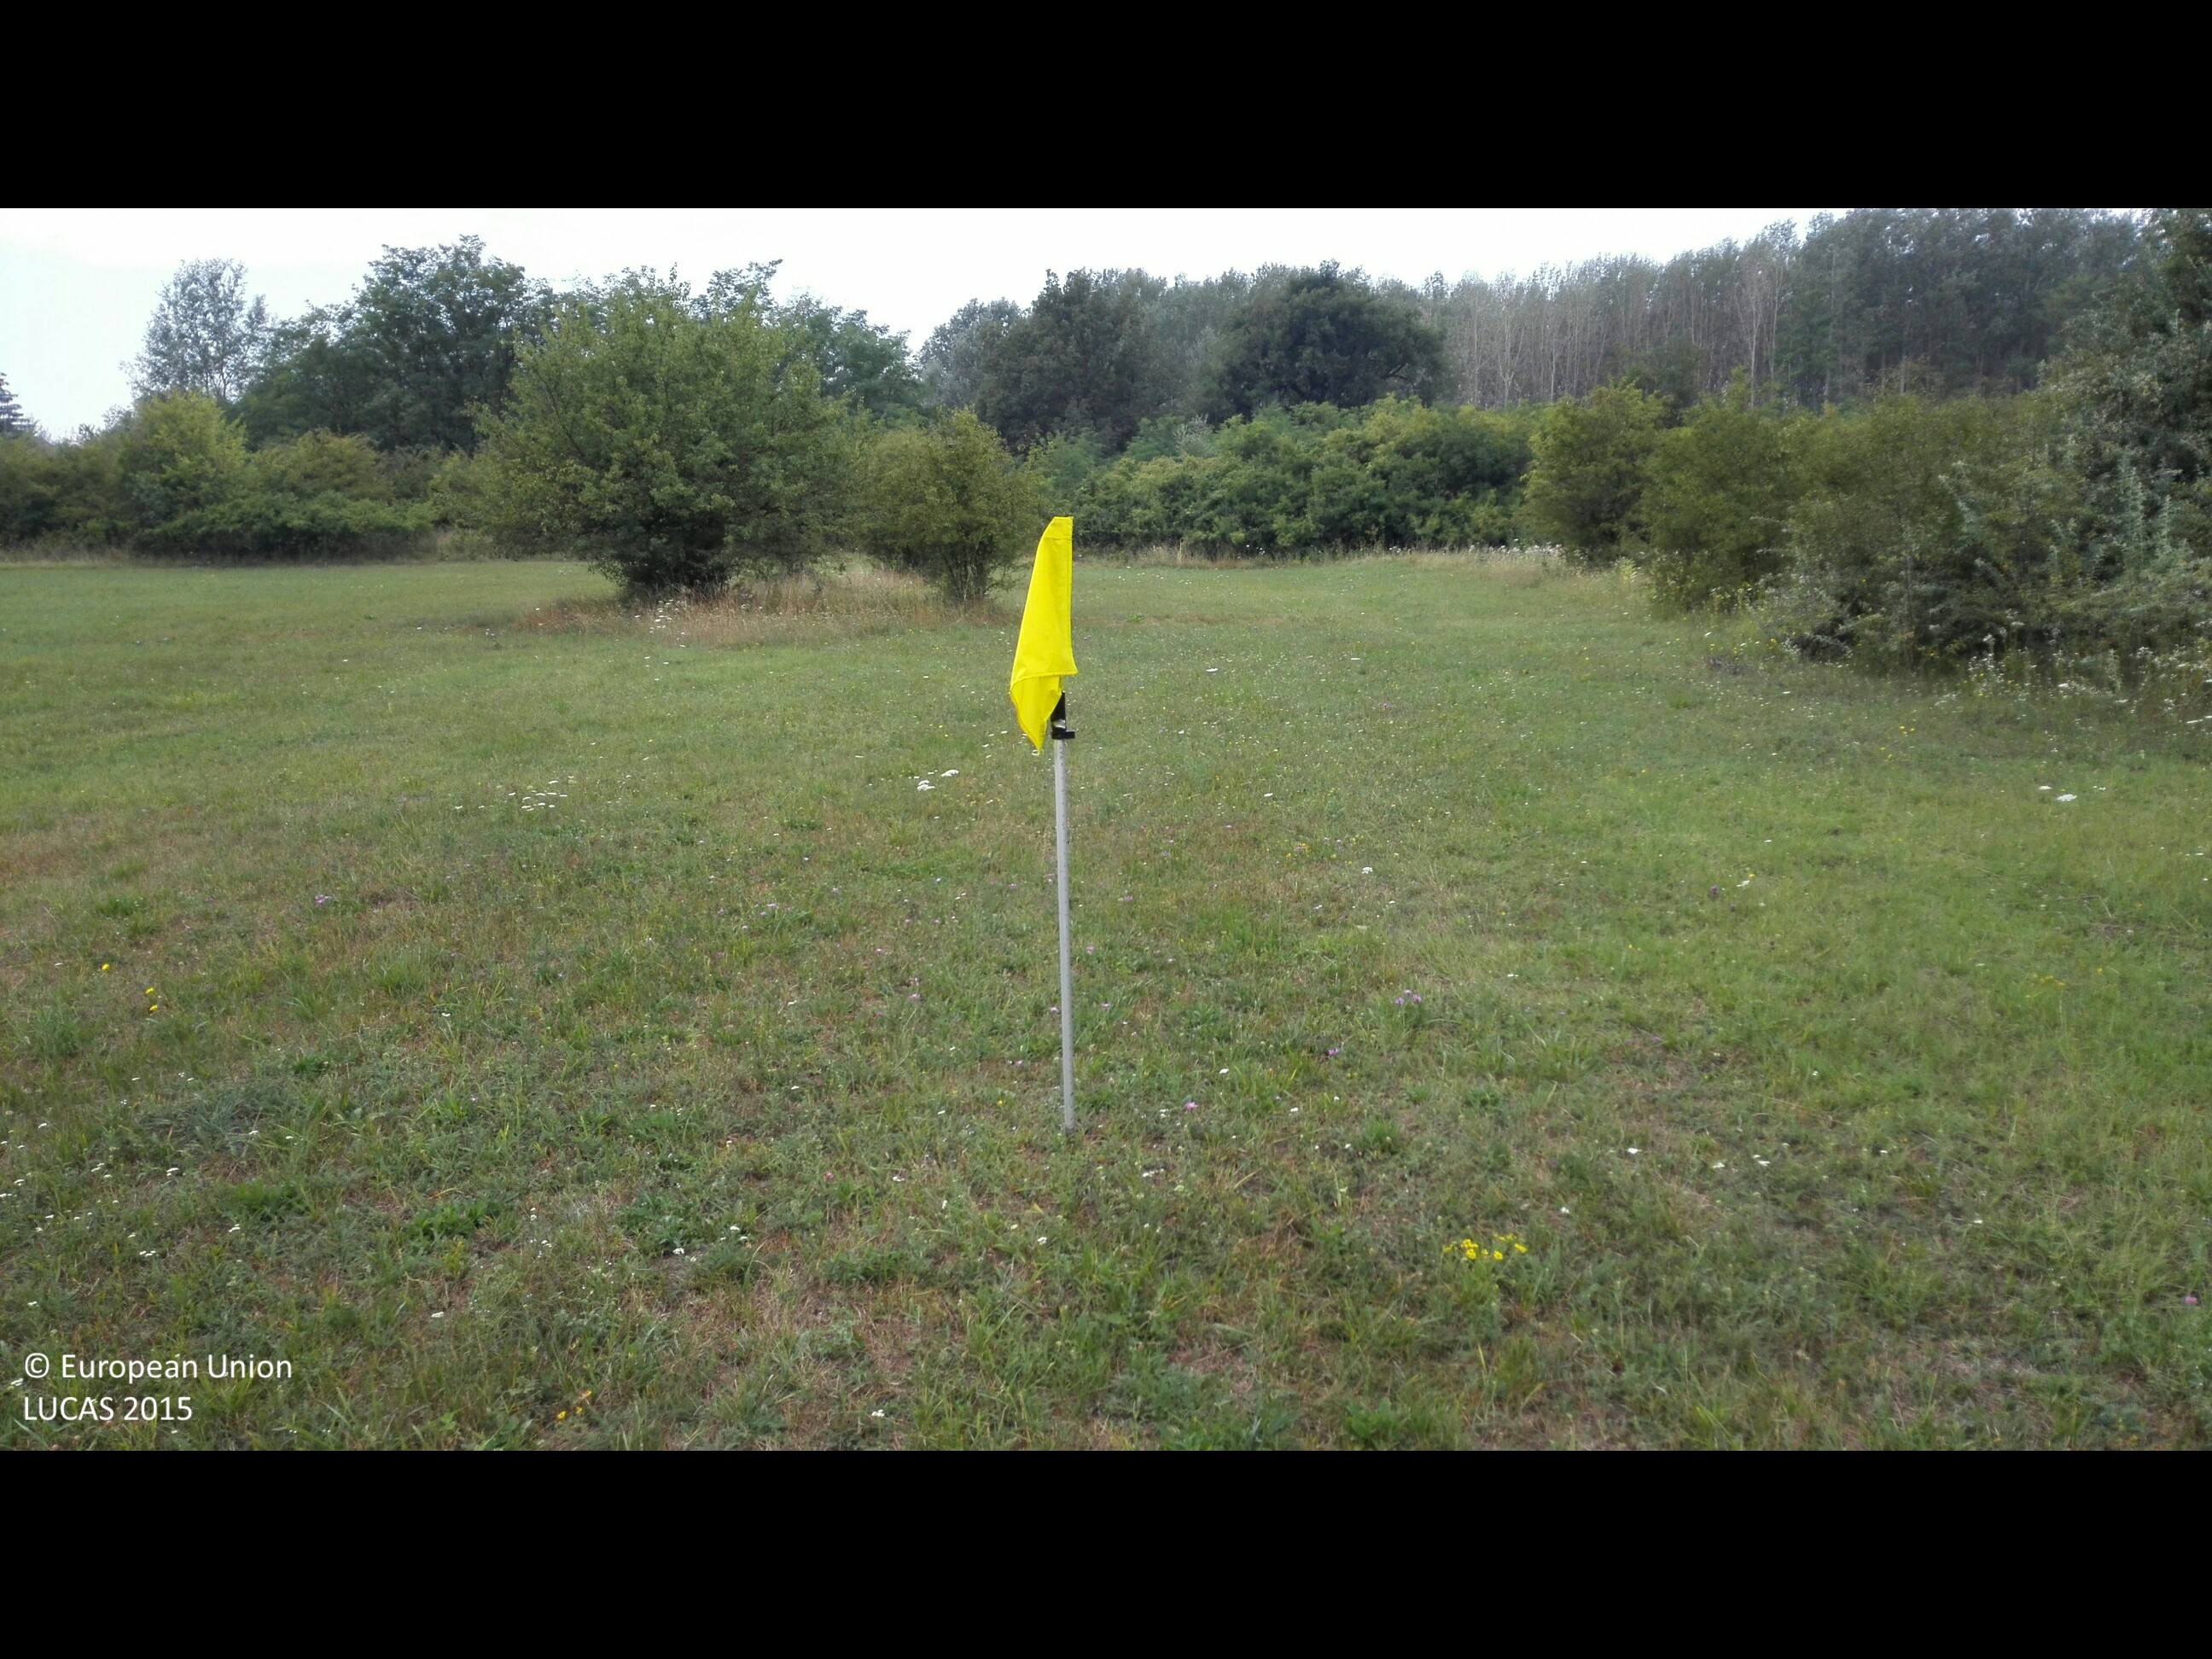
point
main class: Grassland
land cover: Grassland without tree/shrub cover
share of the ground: > 75 %
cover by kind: herbaceous plants 100 %
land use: Agriculture (excluding fallow land and kitchen gardens)
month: August
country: HU
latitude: 47.5410
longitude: 21.7239
